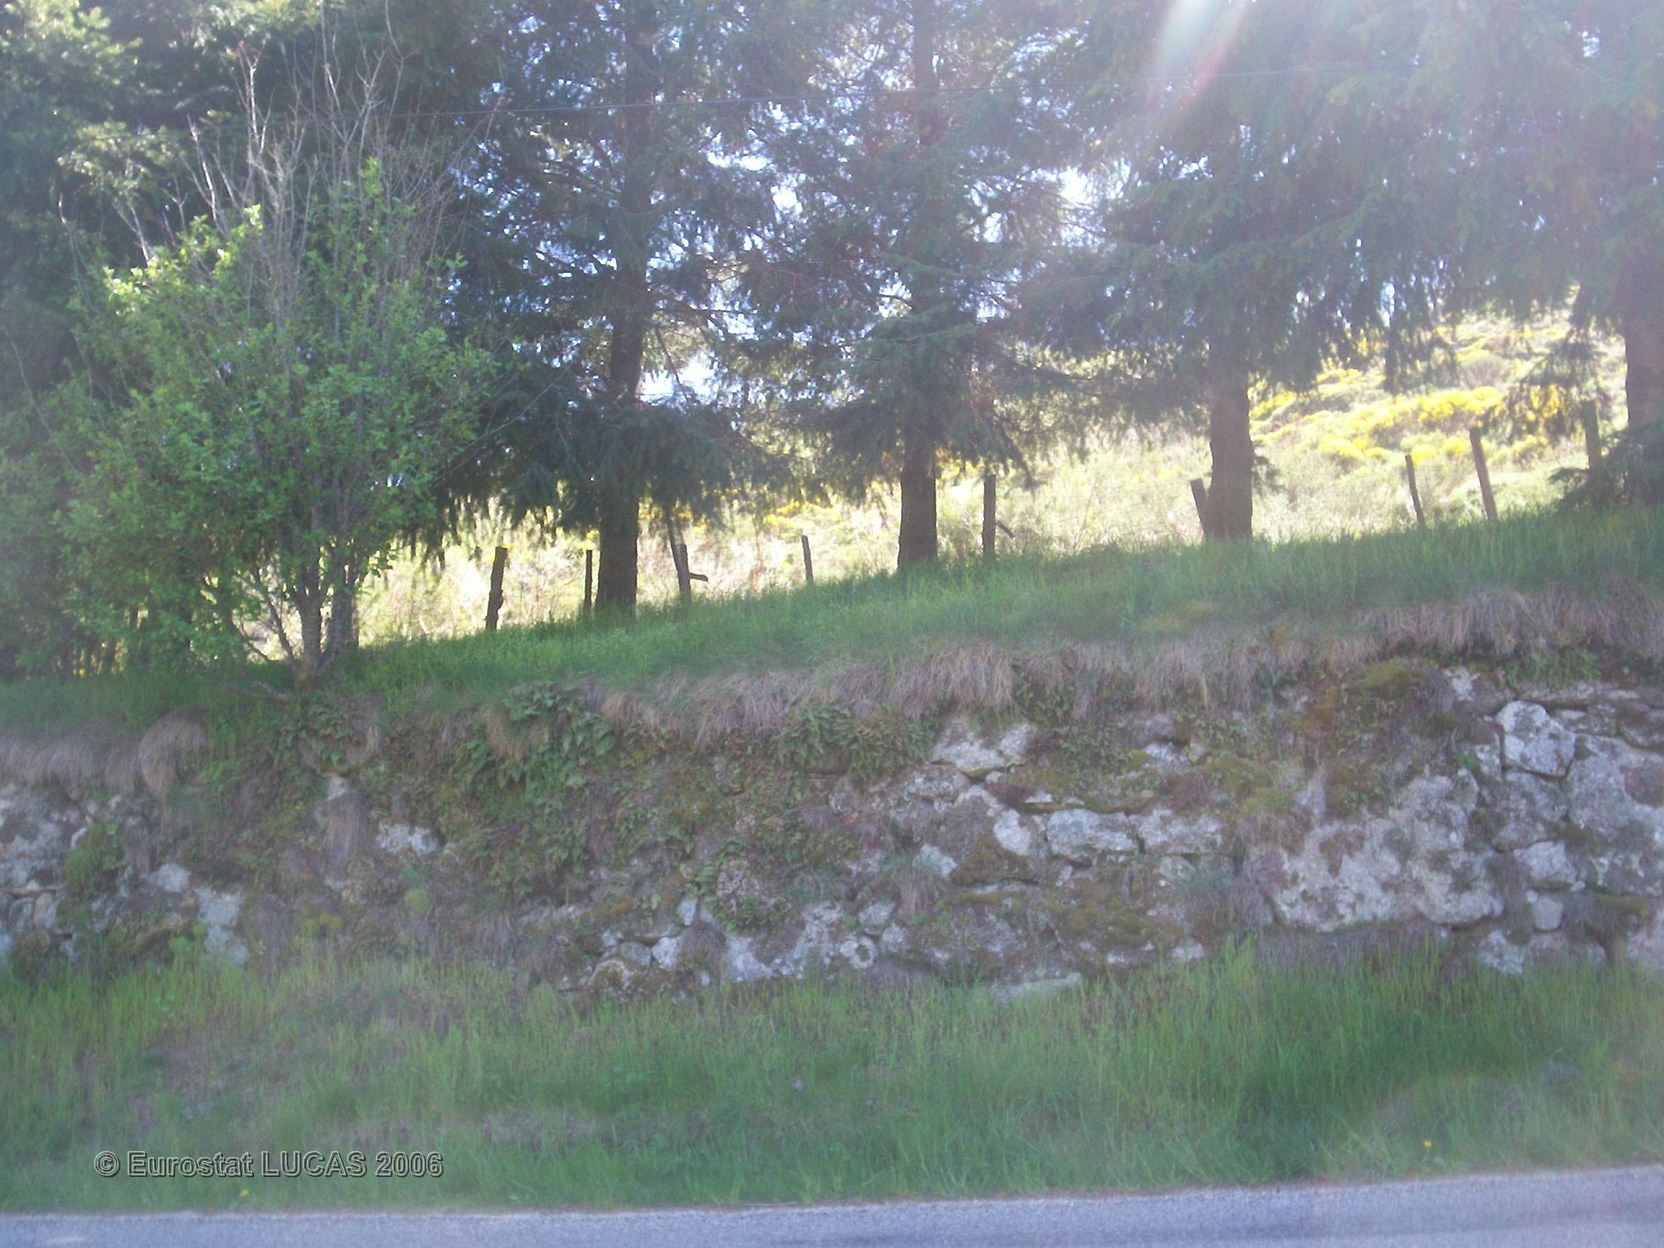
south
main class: Grassland
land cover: Grassland with sparse tree/shrub cover
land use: Unused
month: May
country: FR
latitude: 44.0517
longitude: 3.4290
